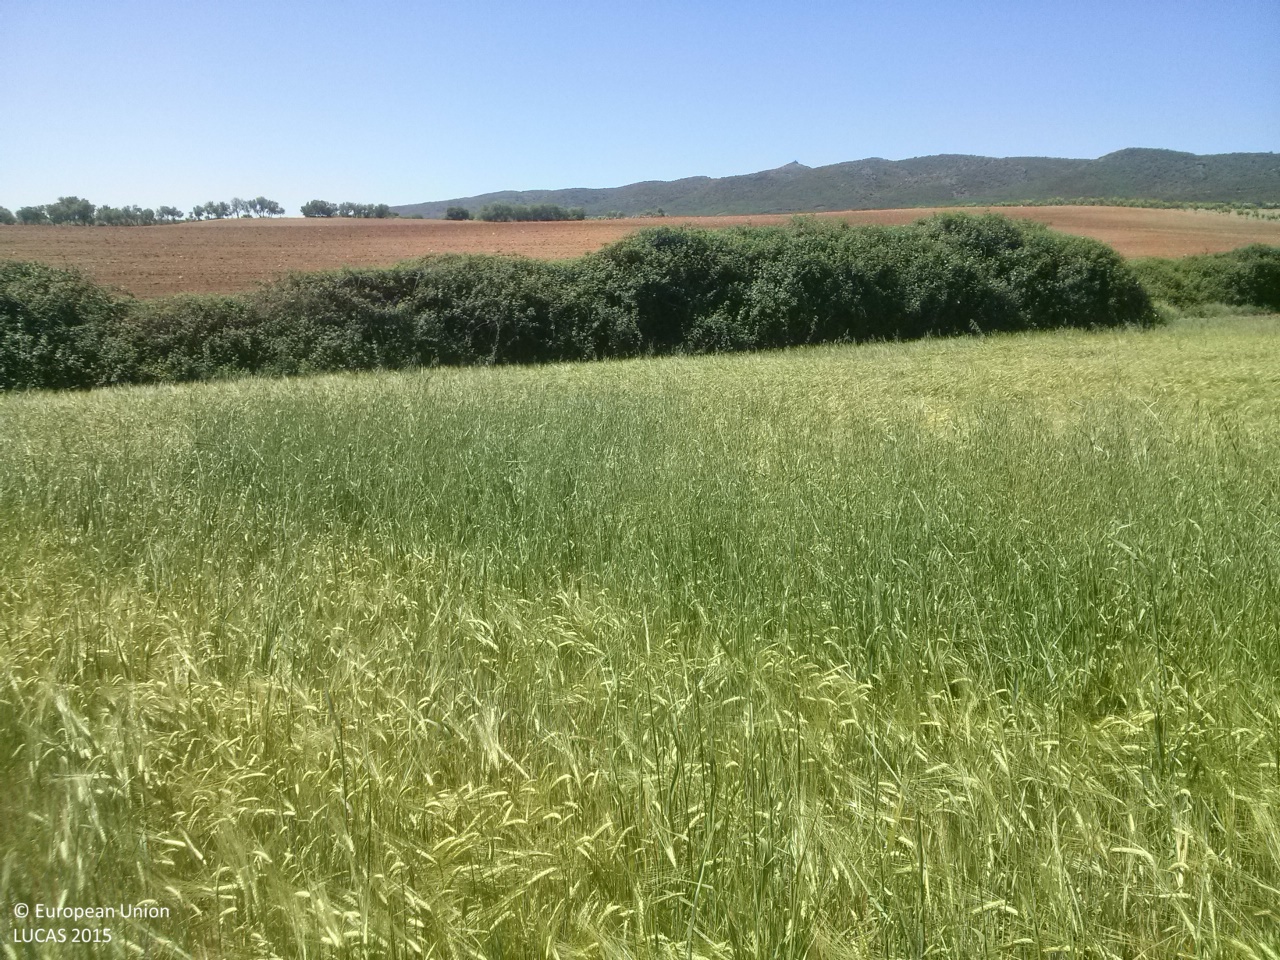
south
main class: Cropland
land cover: Barley
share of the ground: > 75 %
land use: Agriculture (excluding fallow land and kitchen gardens)
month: May
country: ES
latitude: 40.2122
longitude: -2.7960
